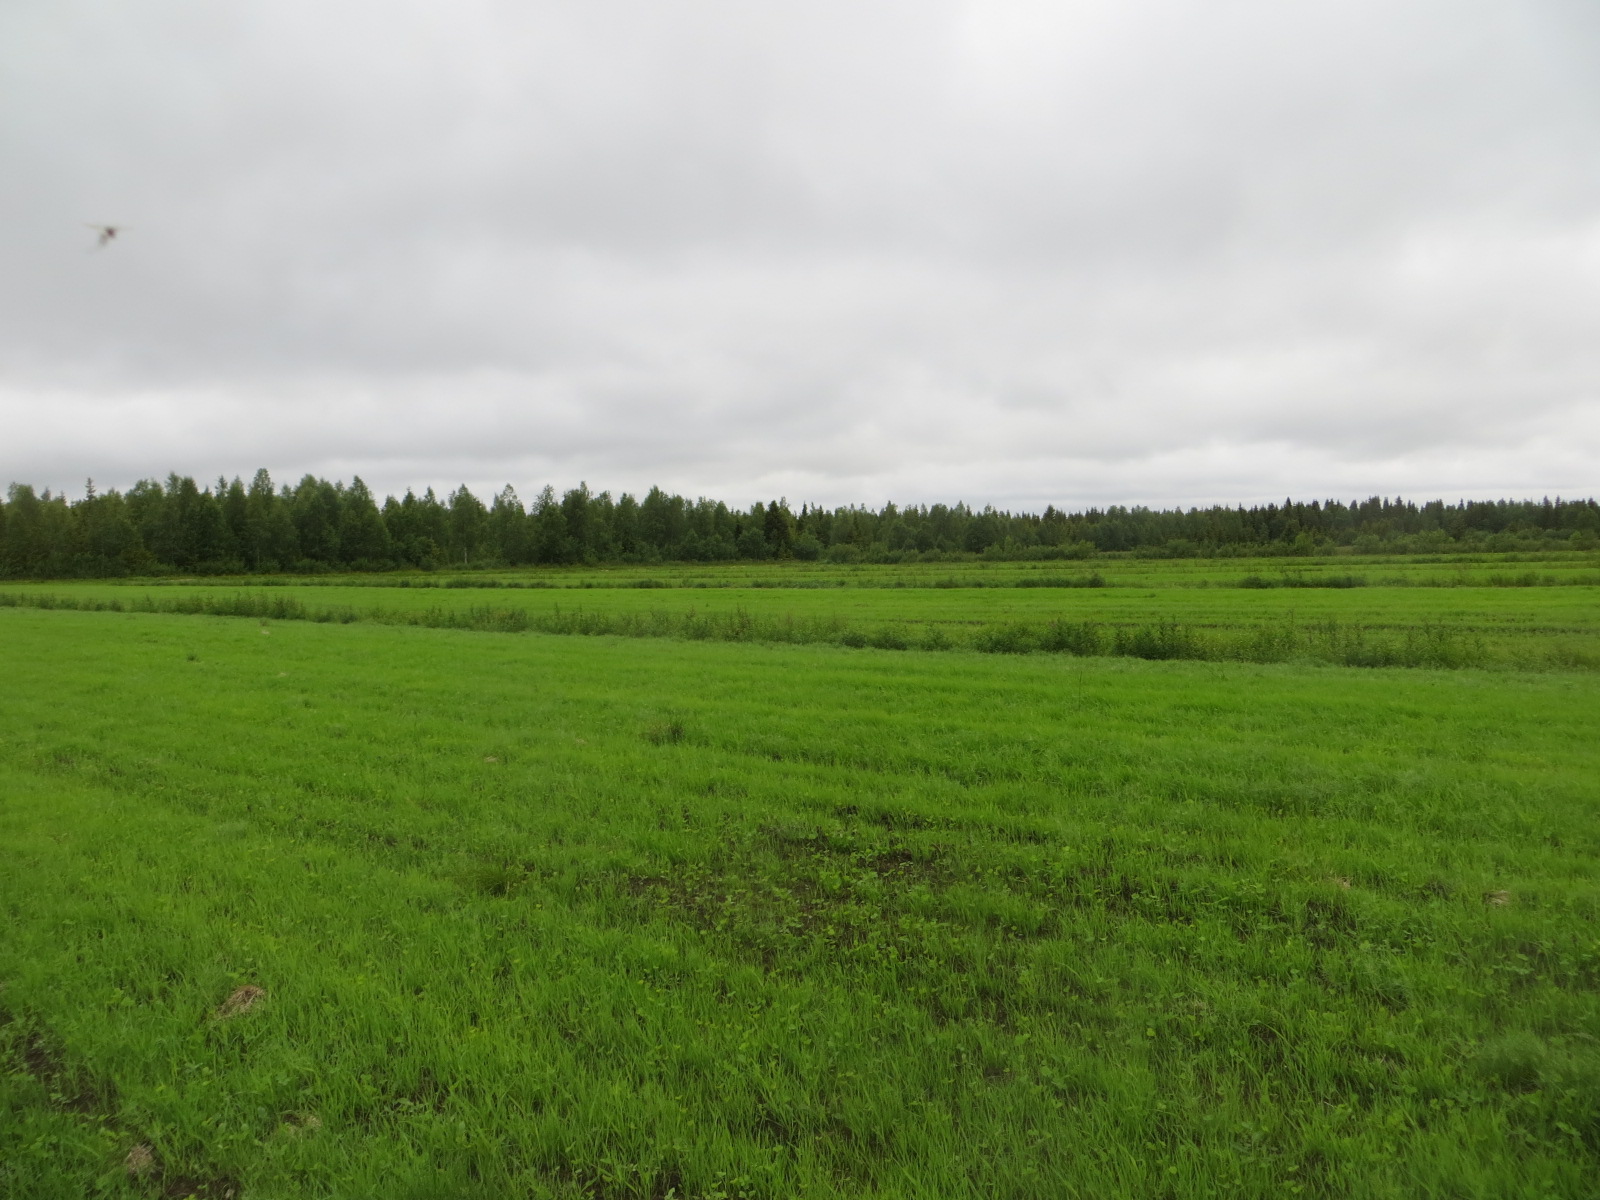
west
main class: Cropland
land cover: Temporary grasslands
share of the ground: 25 - 50 %
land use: Agriculture (excluding fallow land and kitchen gardens)
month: July
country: FI
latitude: 66.3943
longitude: 24.3892
